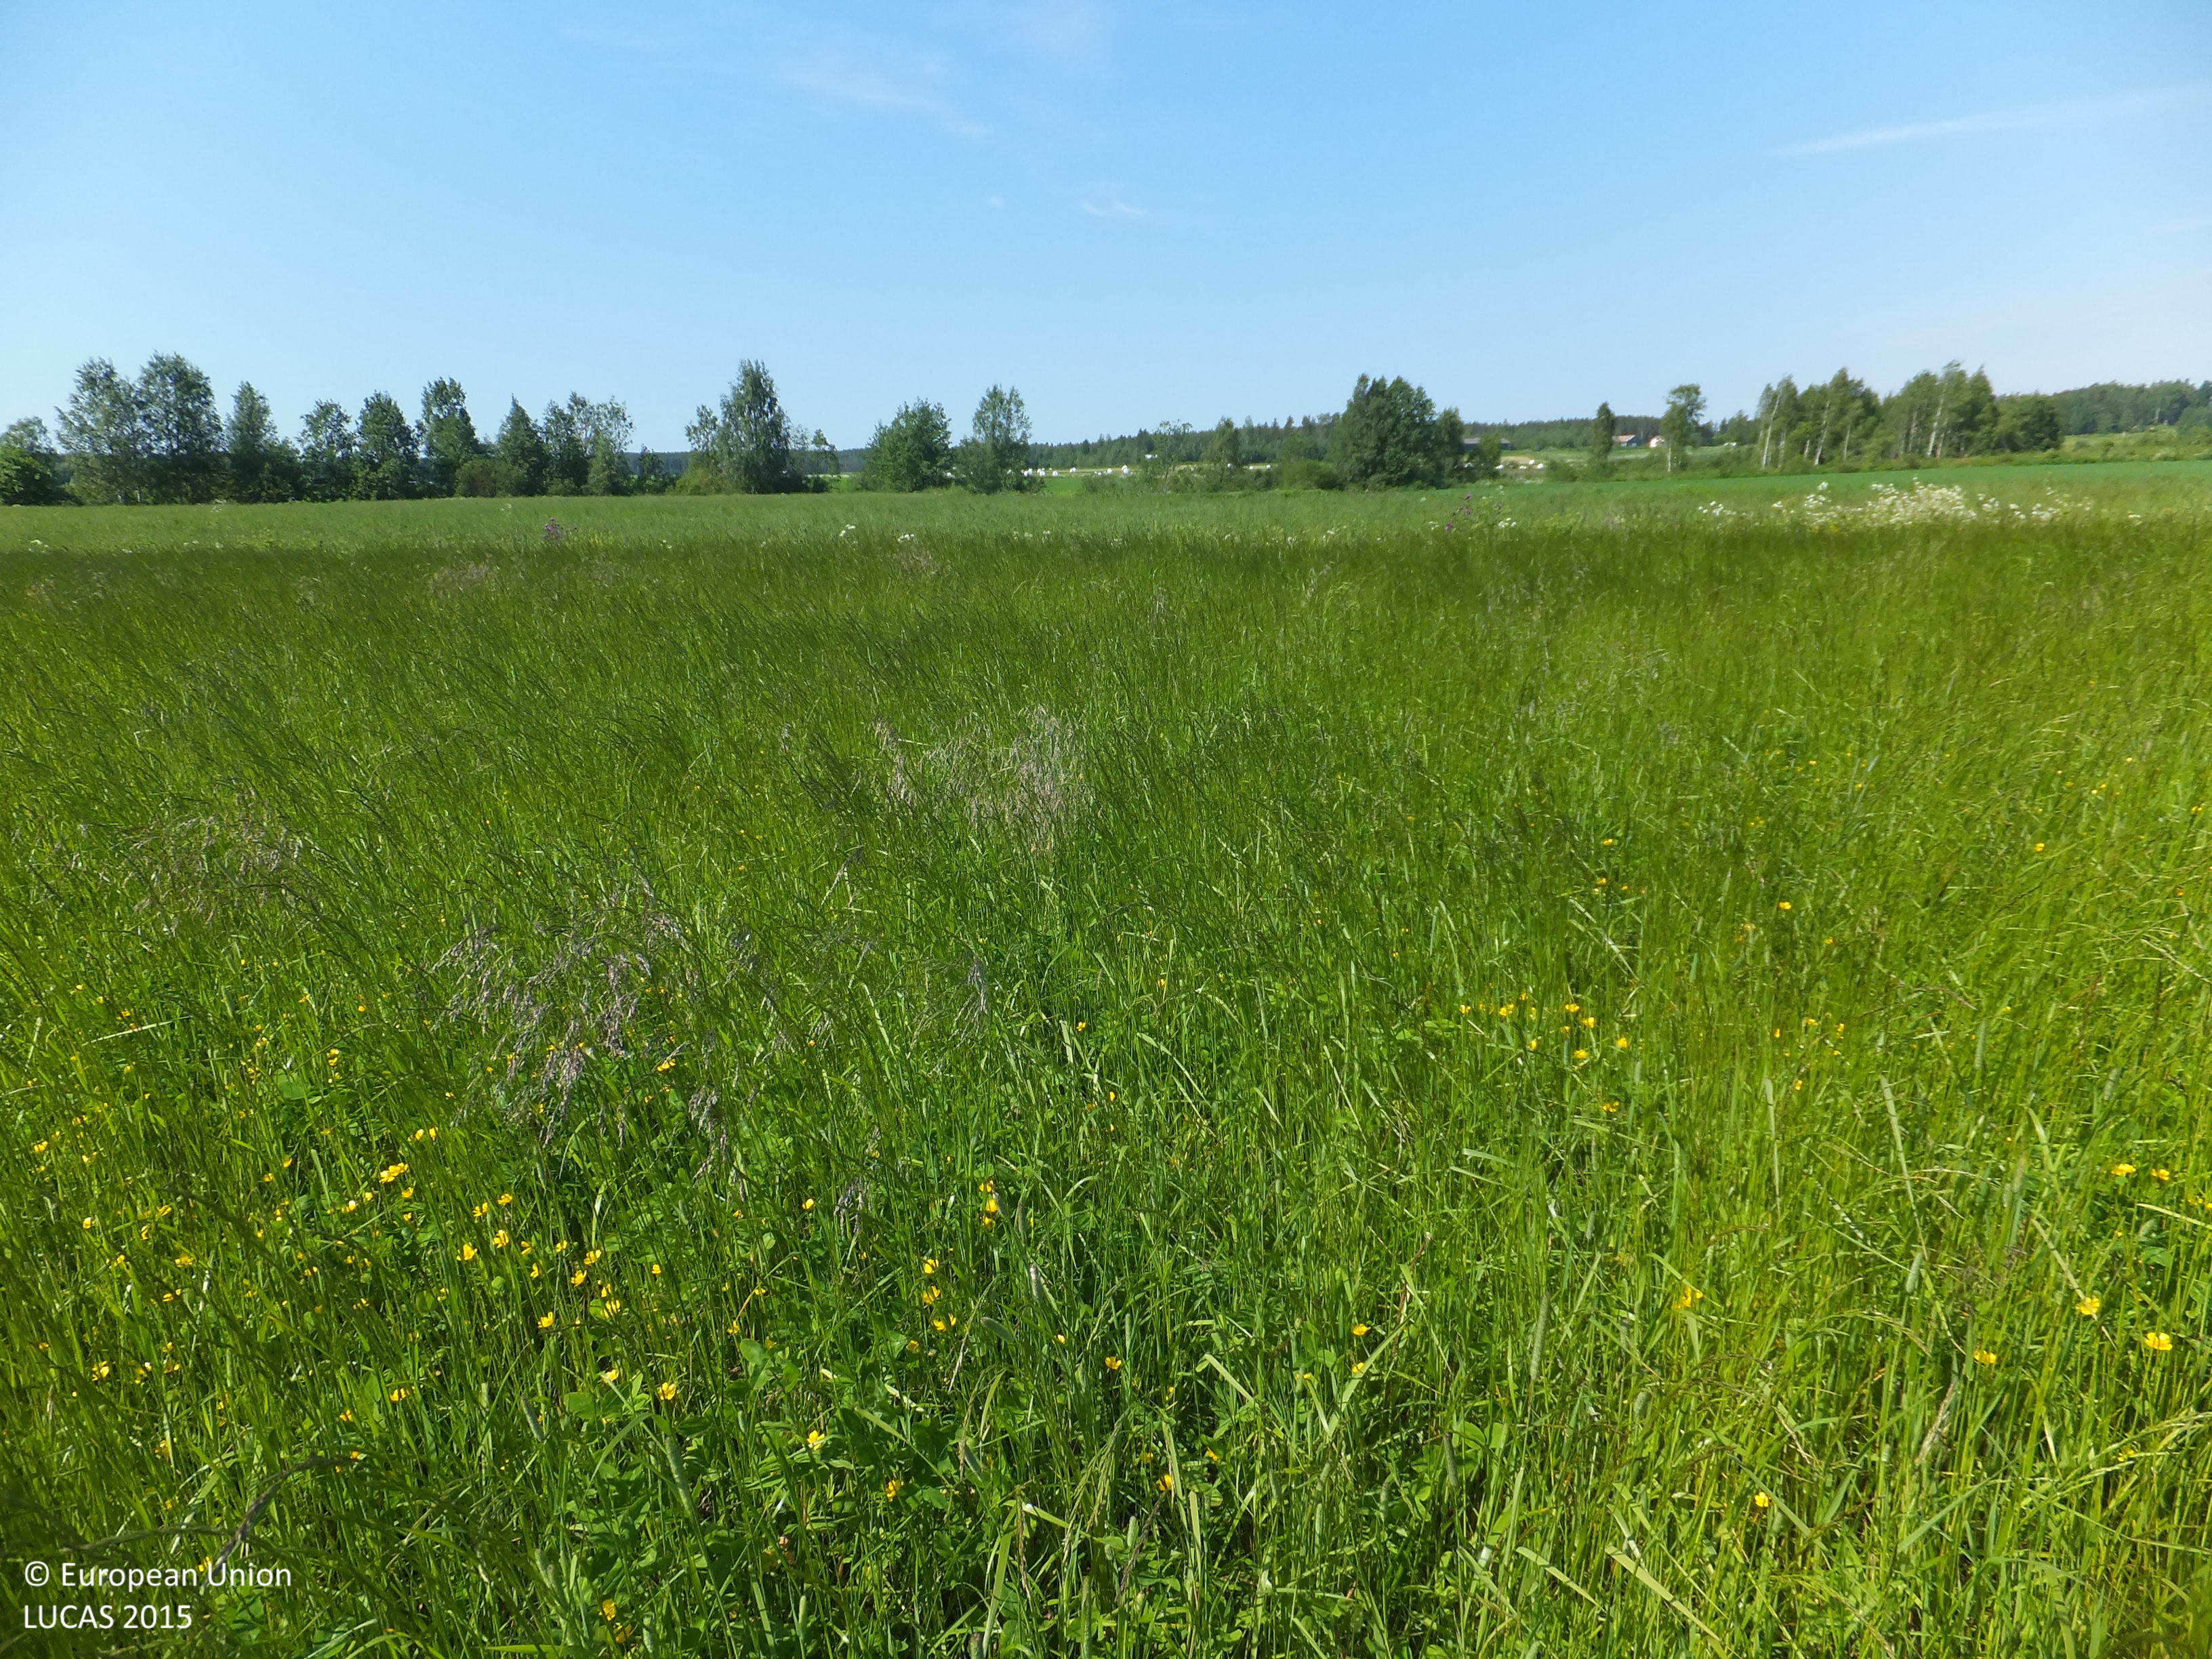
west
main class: Cropland
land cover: Temporary grasslands
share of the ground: > 75 %
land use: Agriculture (excluding fallow land and kitchen gardens)
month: July
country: FI
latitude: 63.2413
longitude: 23.7859
